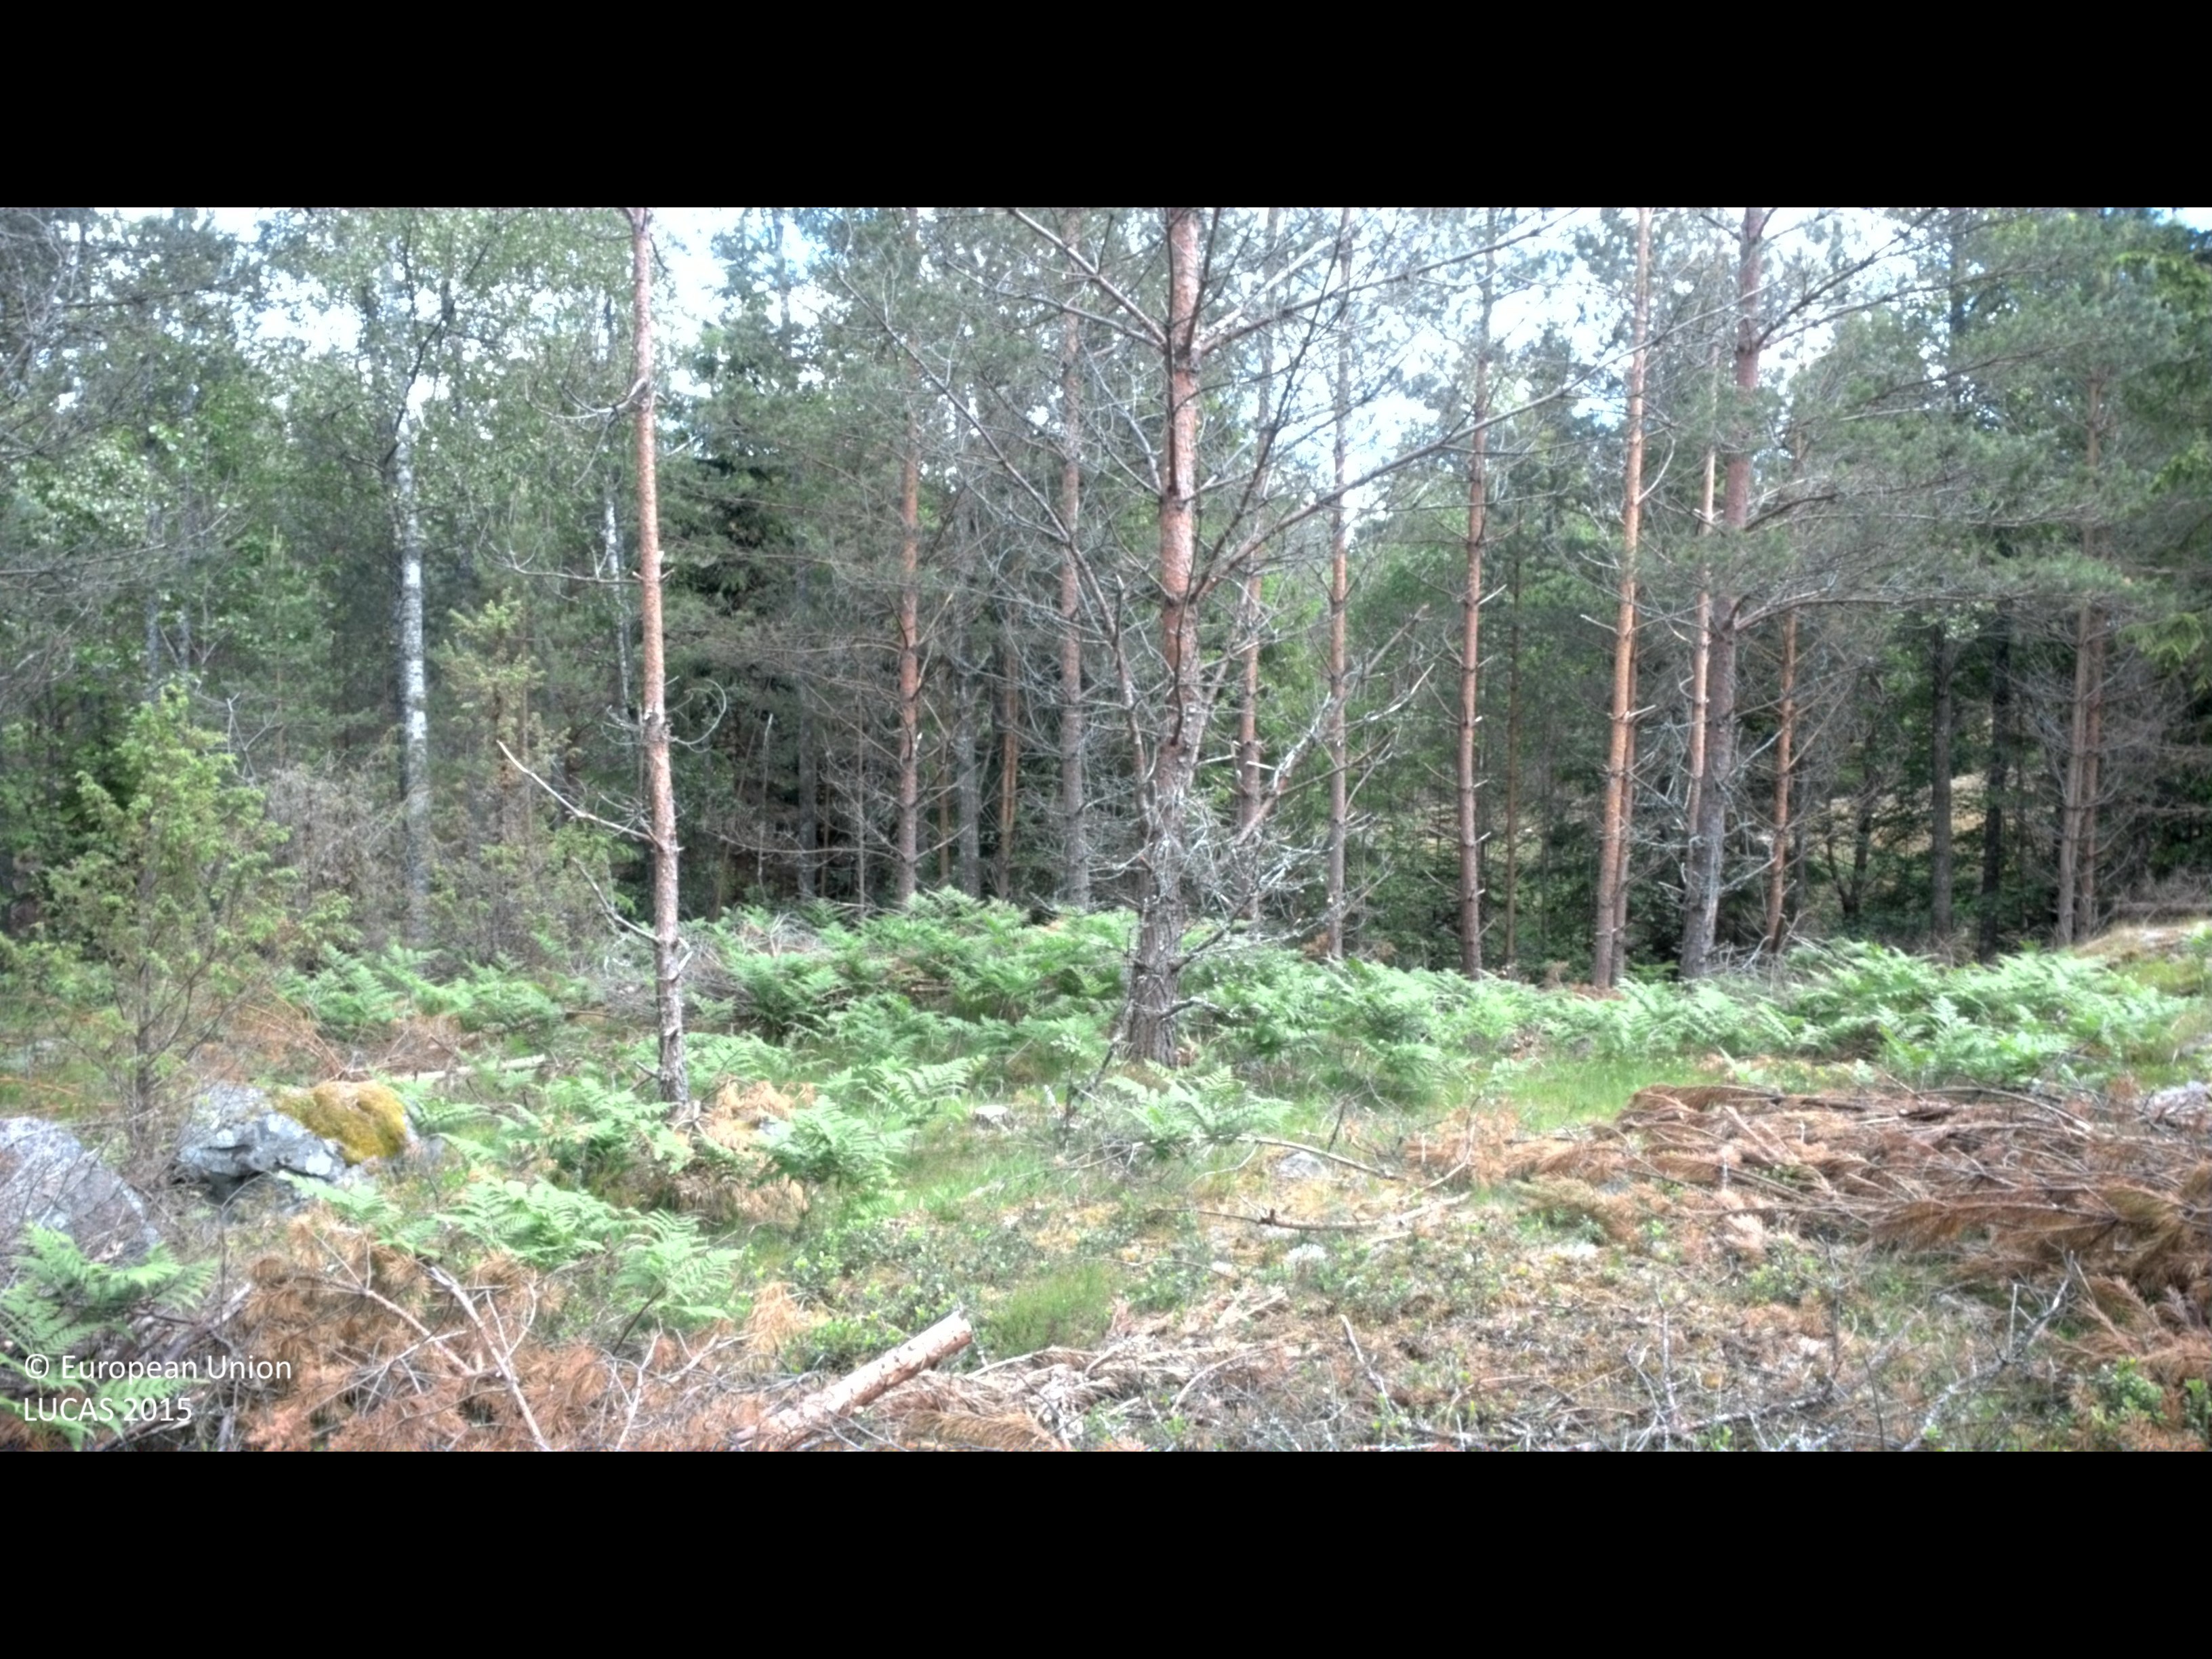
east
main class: Woodland
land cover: Pine dominated coniferous woodland
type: boreal forest
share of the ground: 50 - 75 %
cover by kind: coniferous forest trees 60 %, shrubs 20 %, herbaceous plants 10 %, broadleaved forest trees 5 %, unconsolidated bare surface 5 %
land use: Forestry
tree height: > 5 m
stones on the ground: < 10 %
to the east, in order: Pine dominated coniferous woodland; Broadleaved woodland; Pine dominated coniferous woodland; Spruce dominated coniferous woodland; Electric lines; Pine dominated coniferous woodland; Paved roads, cycling and walking lanes; Pine dominated mixed woodland
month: June
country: SE
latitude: 57.7000
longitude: 16.5257
